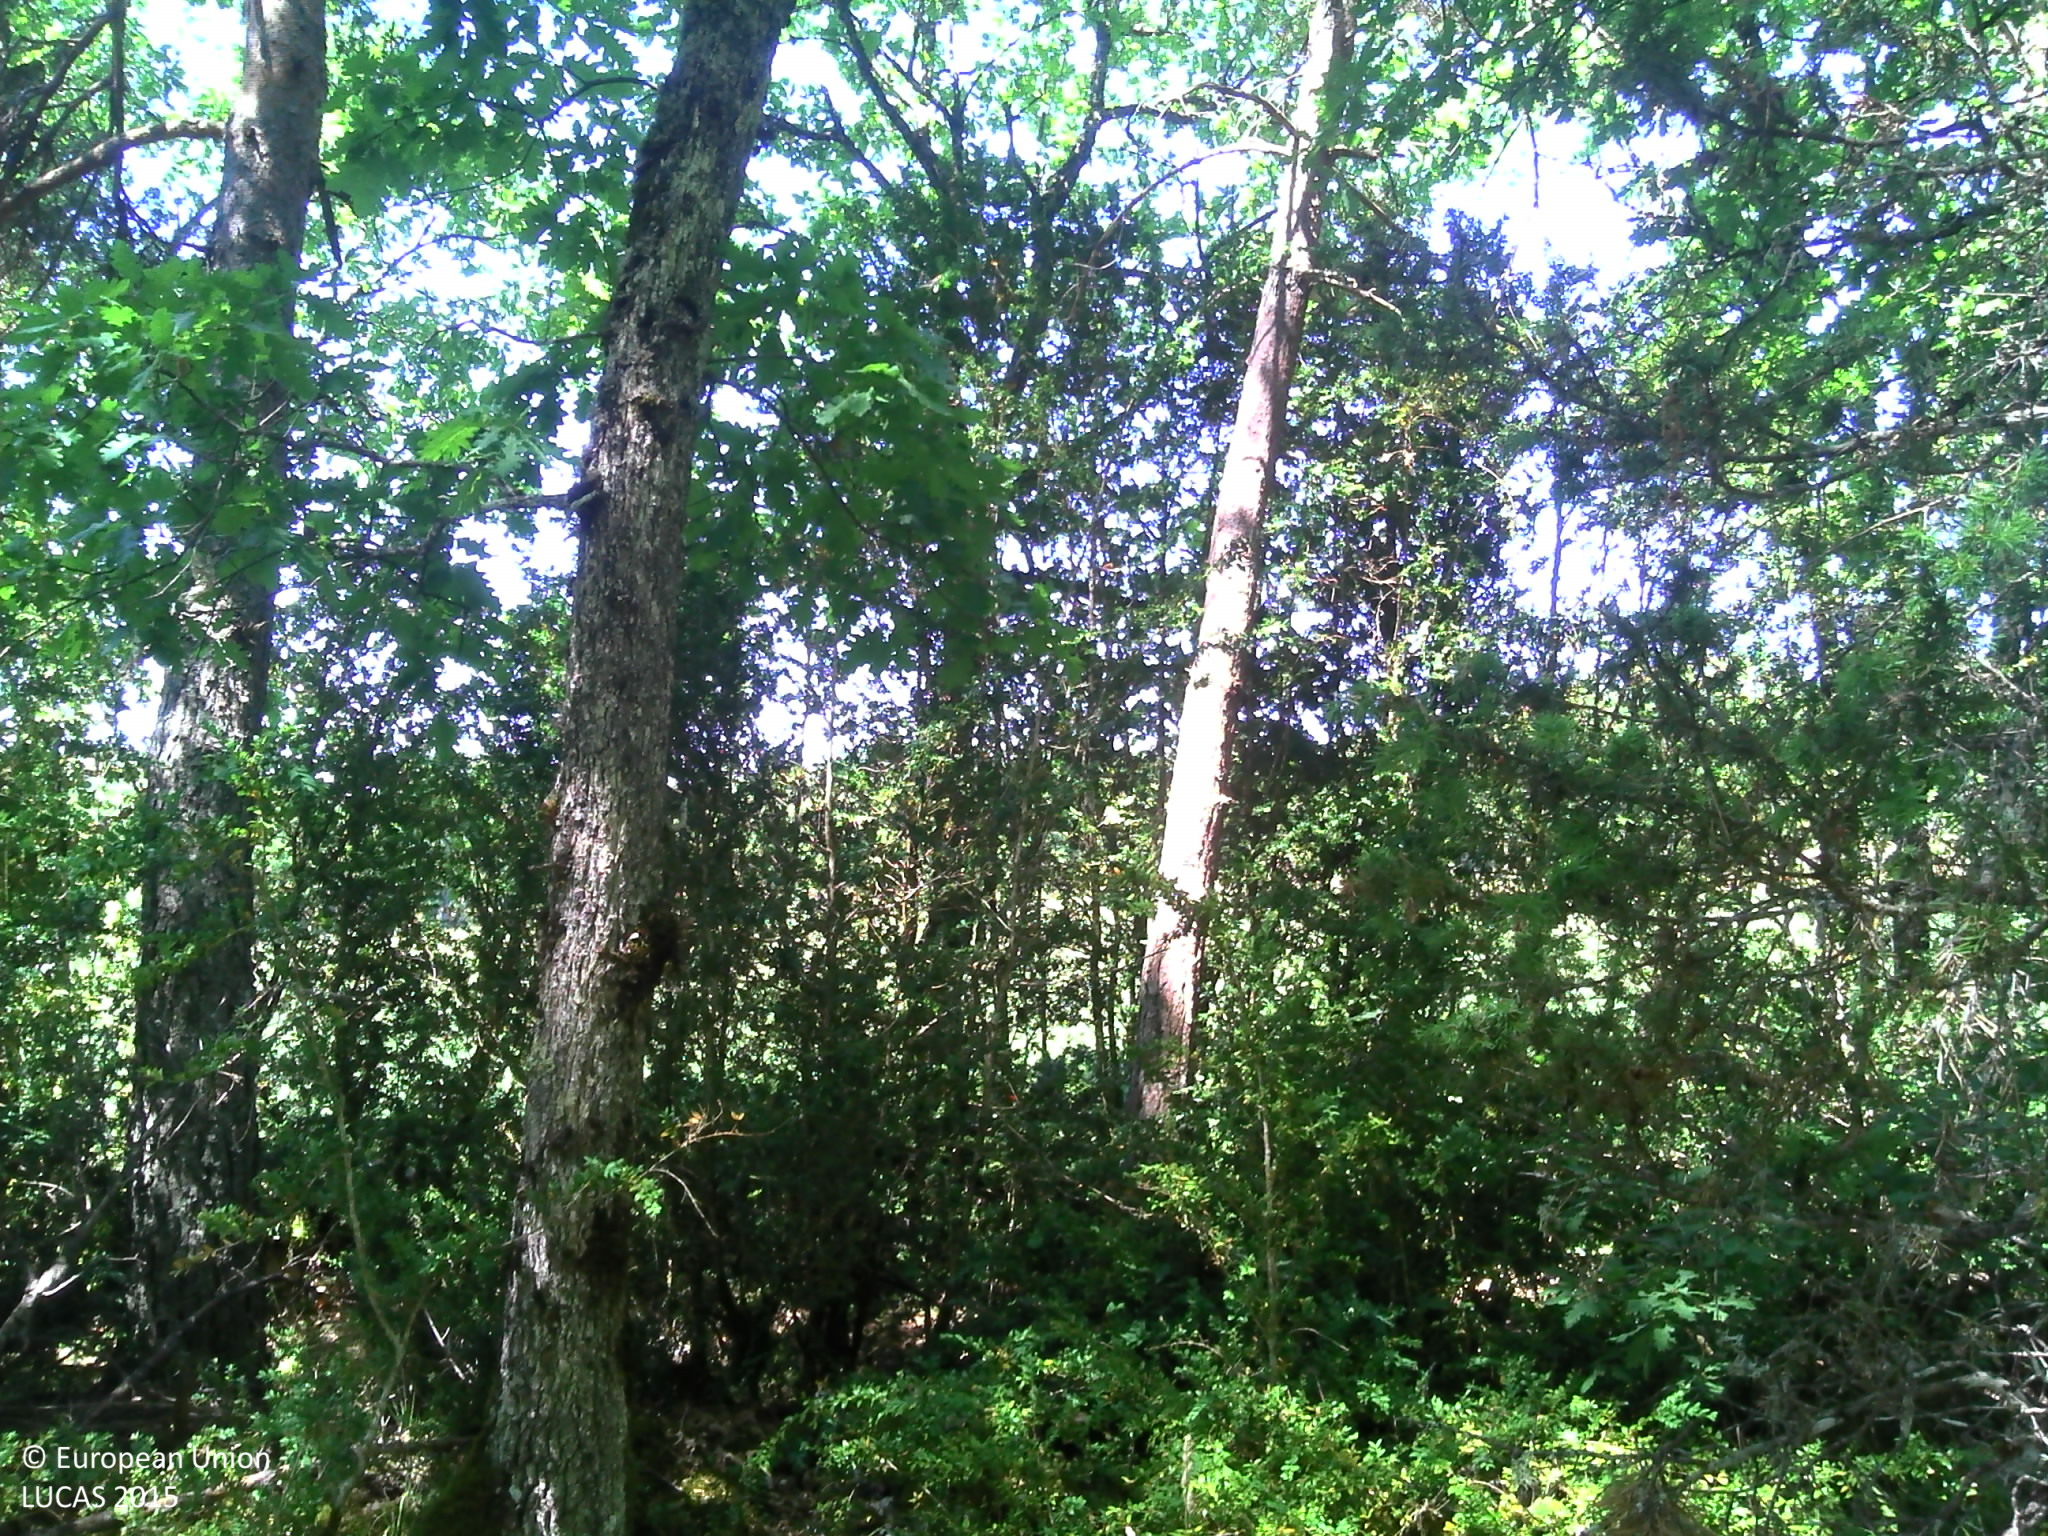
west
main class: Woodland
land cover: Other mixed woodland
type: hemiboreal forest and nemoral coniferous forest and mixed broadleaved-coniferous forest
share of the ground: > 75 %
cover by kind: broadleaved forest trees 75 %, coniferous forest trees 25 %
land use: Forestry
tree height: > 5 m
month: July
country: FR
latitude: 44.3996
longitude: 3.2125
